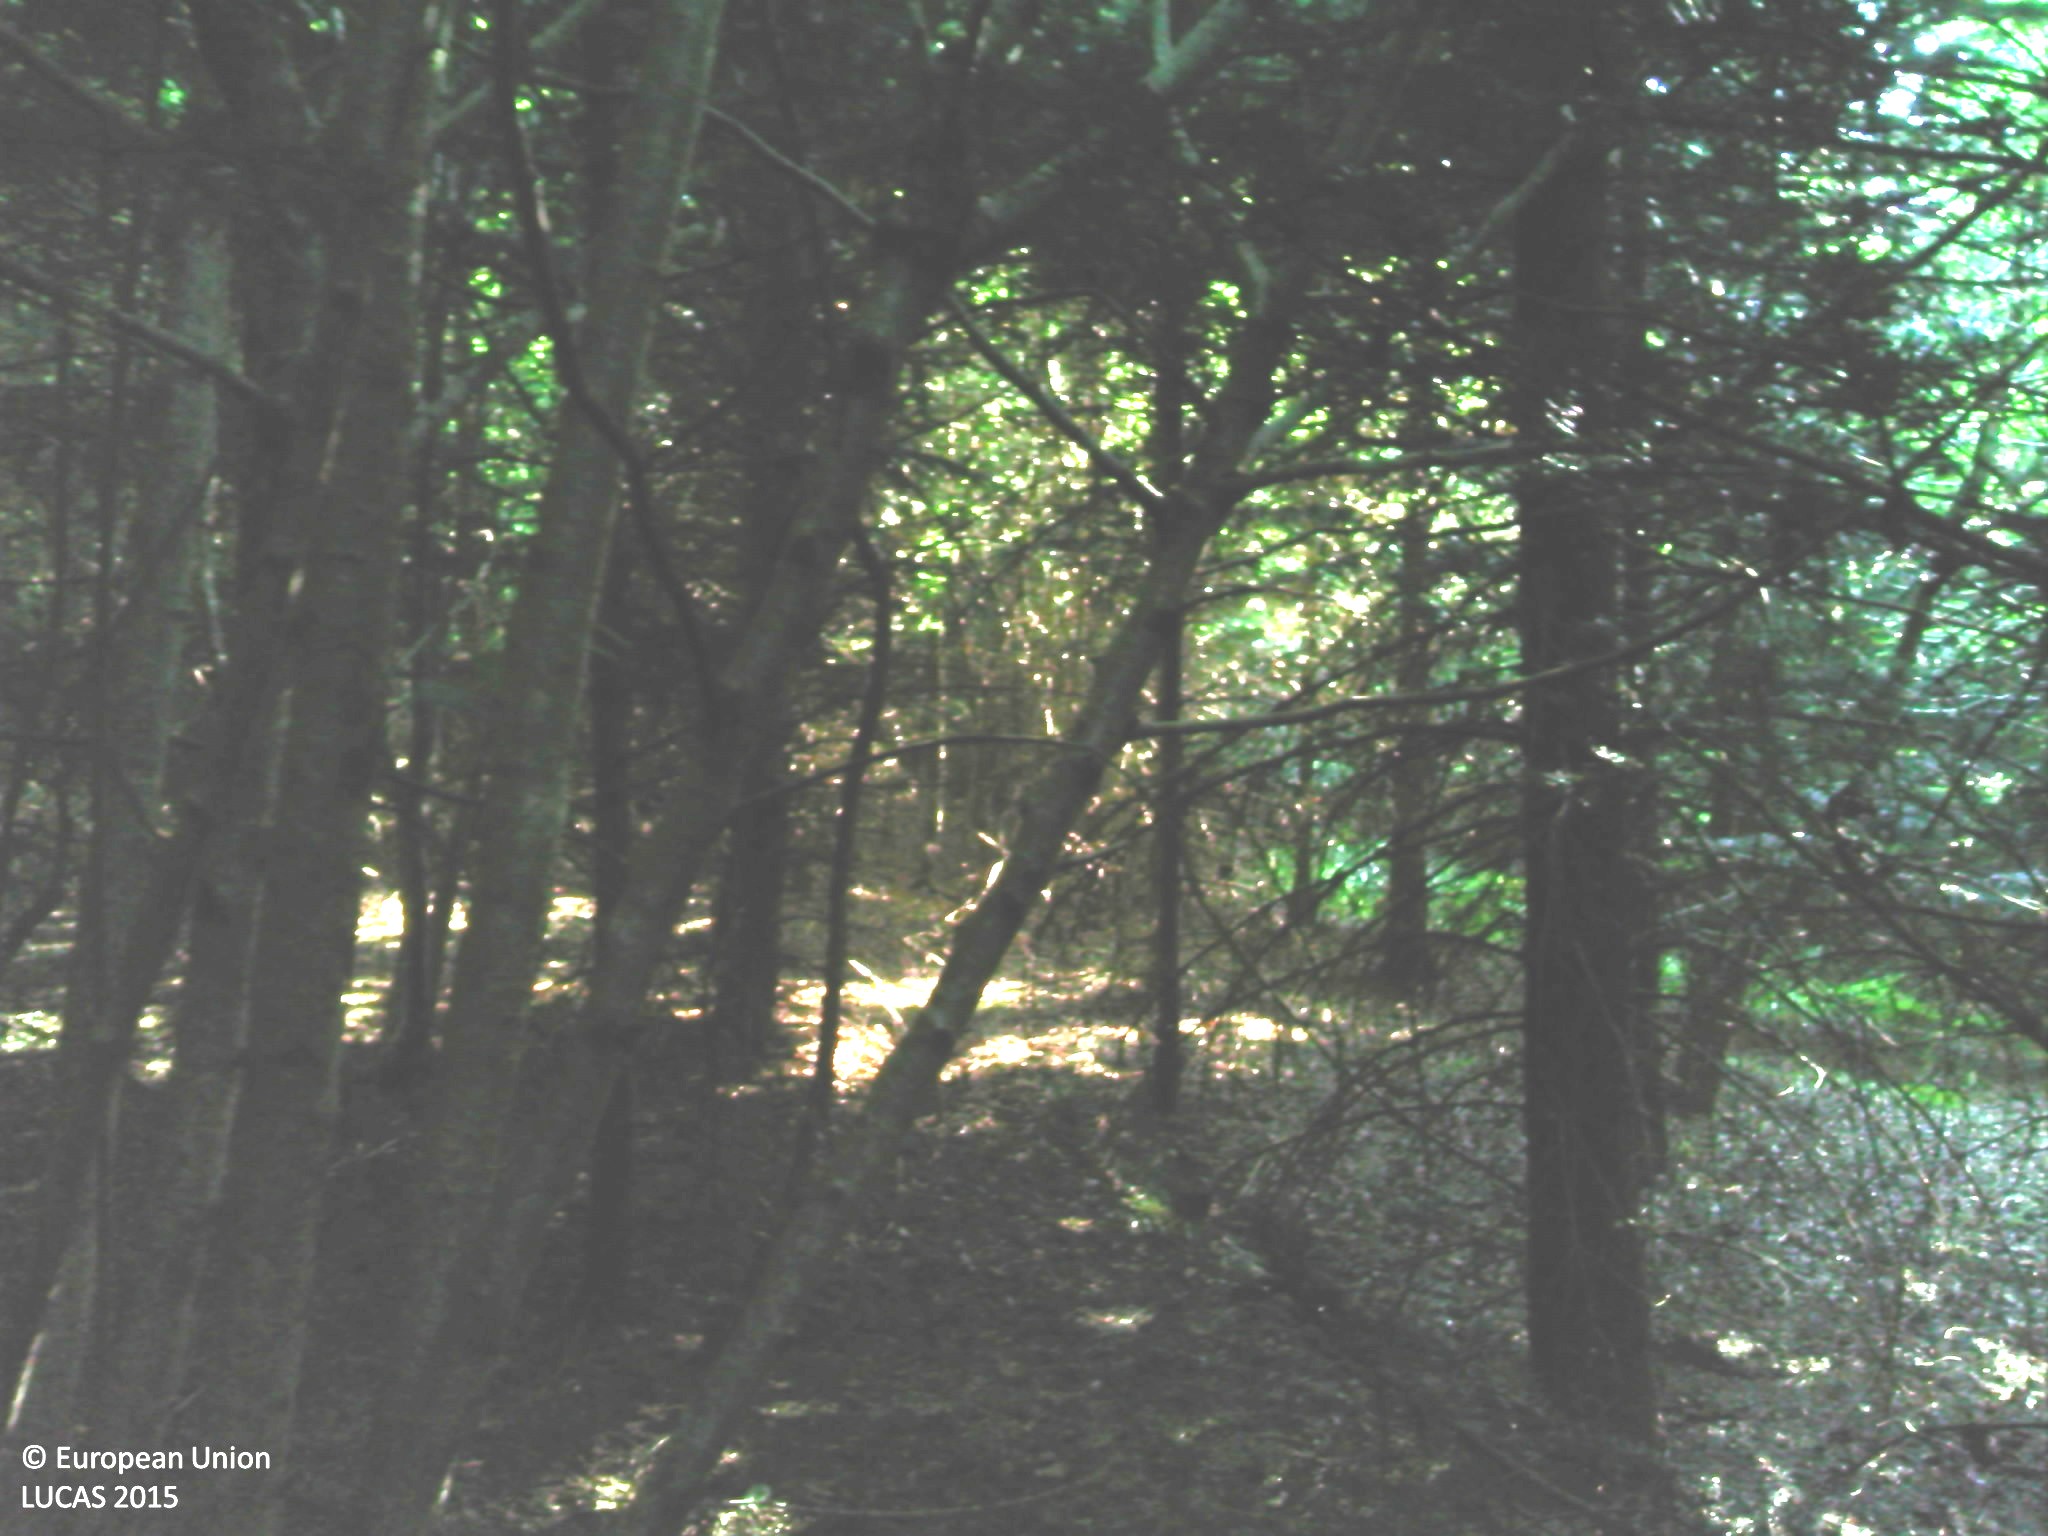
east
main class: Woodland
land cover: Spruce dominated coniferous woodland
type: exotic forest
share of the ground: > 75 %
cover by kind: coniferous forest trees 100 %
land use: Forestry
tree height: > 5 m
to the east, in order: Spruce dominated coniferous woodland; Dry stone walls; Broadleaved woodland; Spruce dominated coniferous woodland; Dry stone walls; Broadleaved woodland; Spruce dominated coniferous woodland; Broadleaved woodland; Fences; Grassland without tree/shrub cover
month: July
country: FR
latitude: 47.1173
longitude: 3.9225
